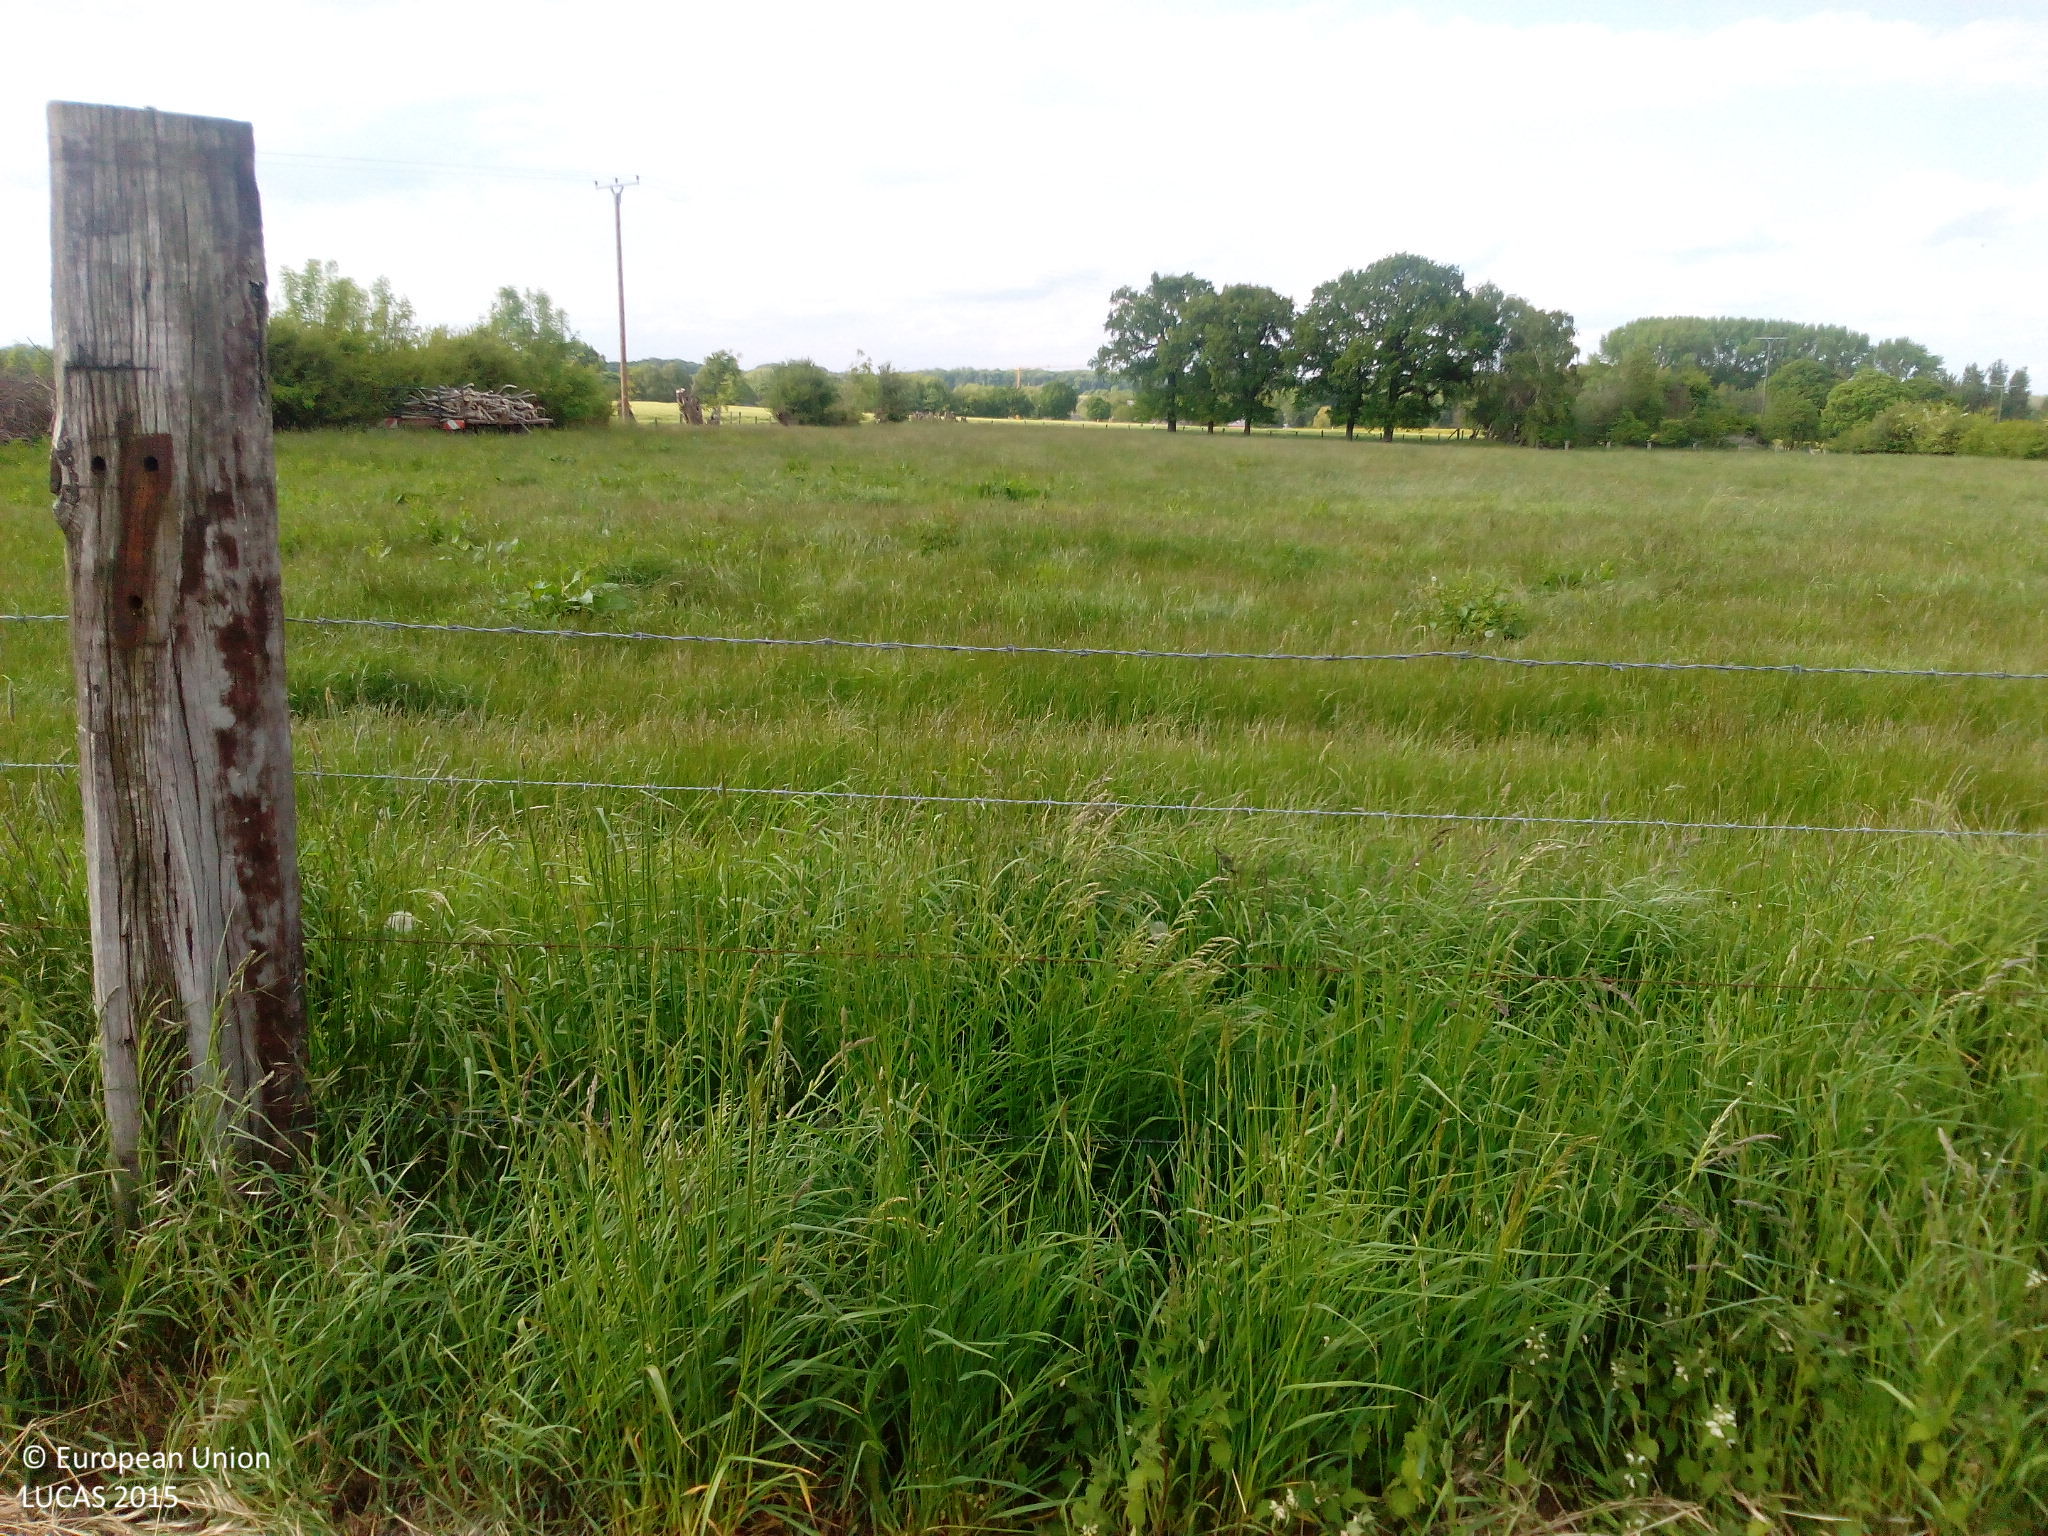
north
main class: Cropland
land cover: Maize
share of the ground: < 10 %
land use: Agriculture (excluding fallow land and kitchen gardens)
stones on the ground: < 10 %
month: May
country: DE
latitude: 51.7491
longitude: 7.9870
